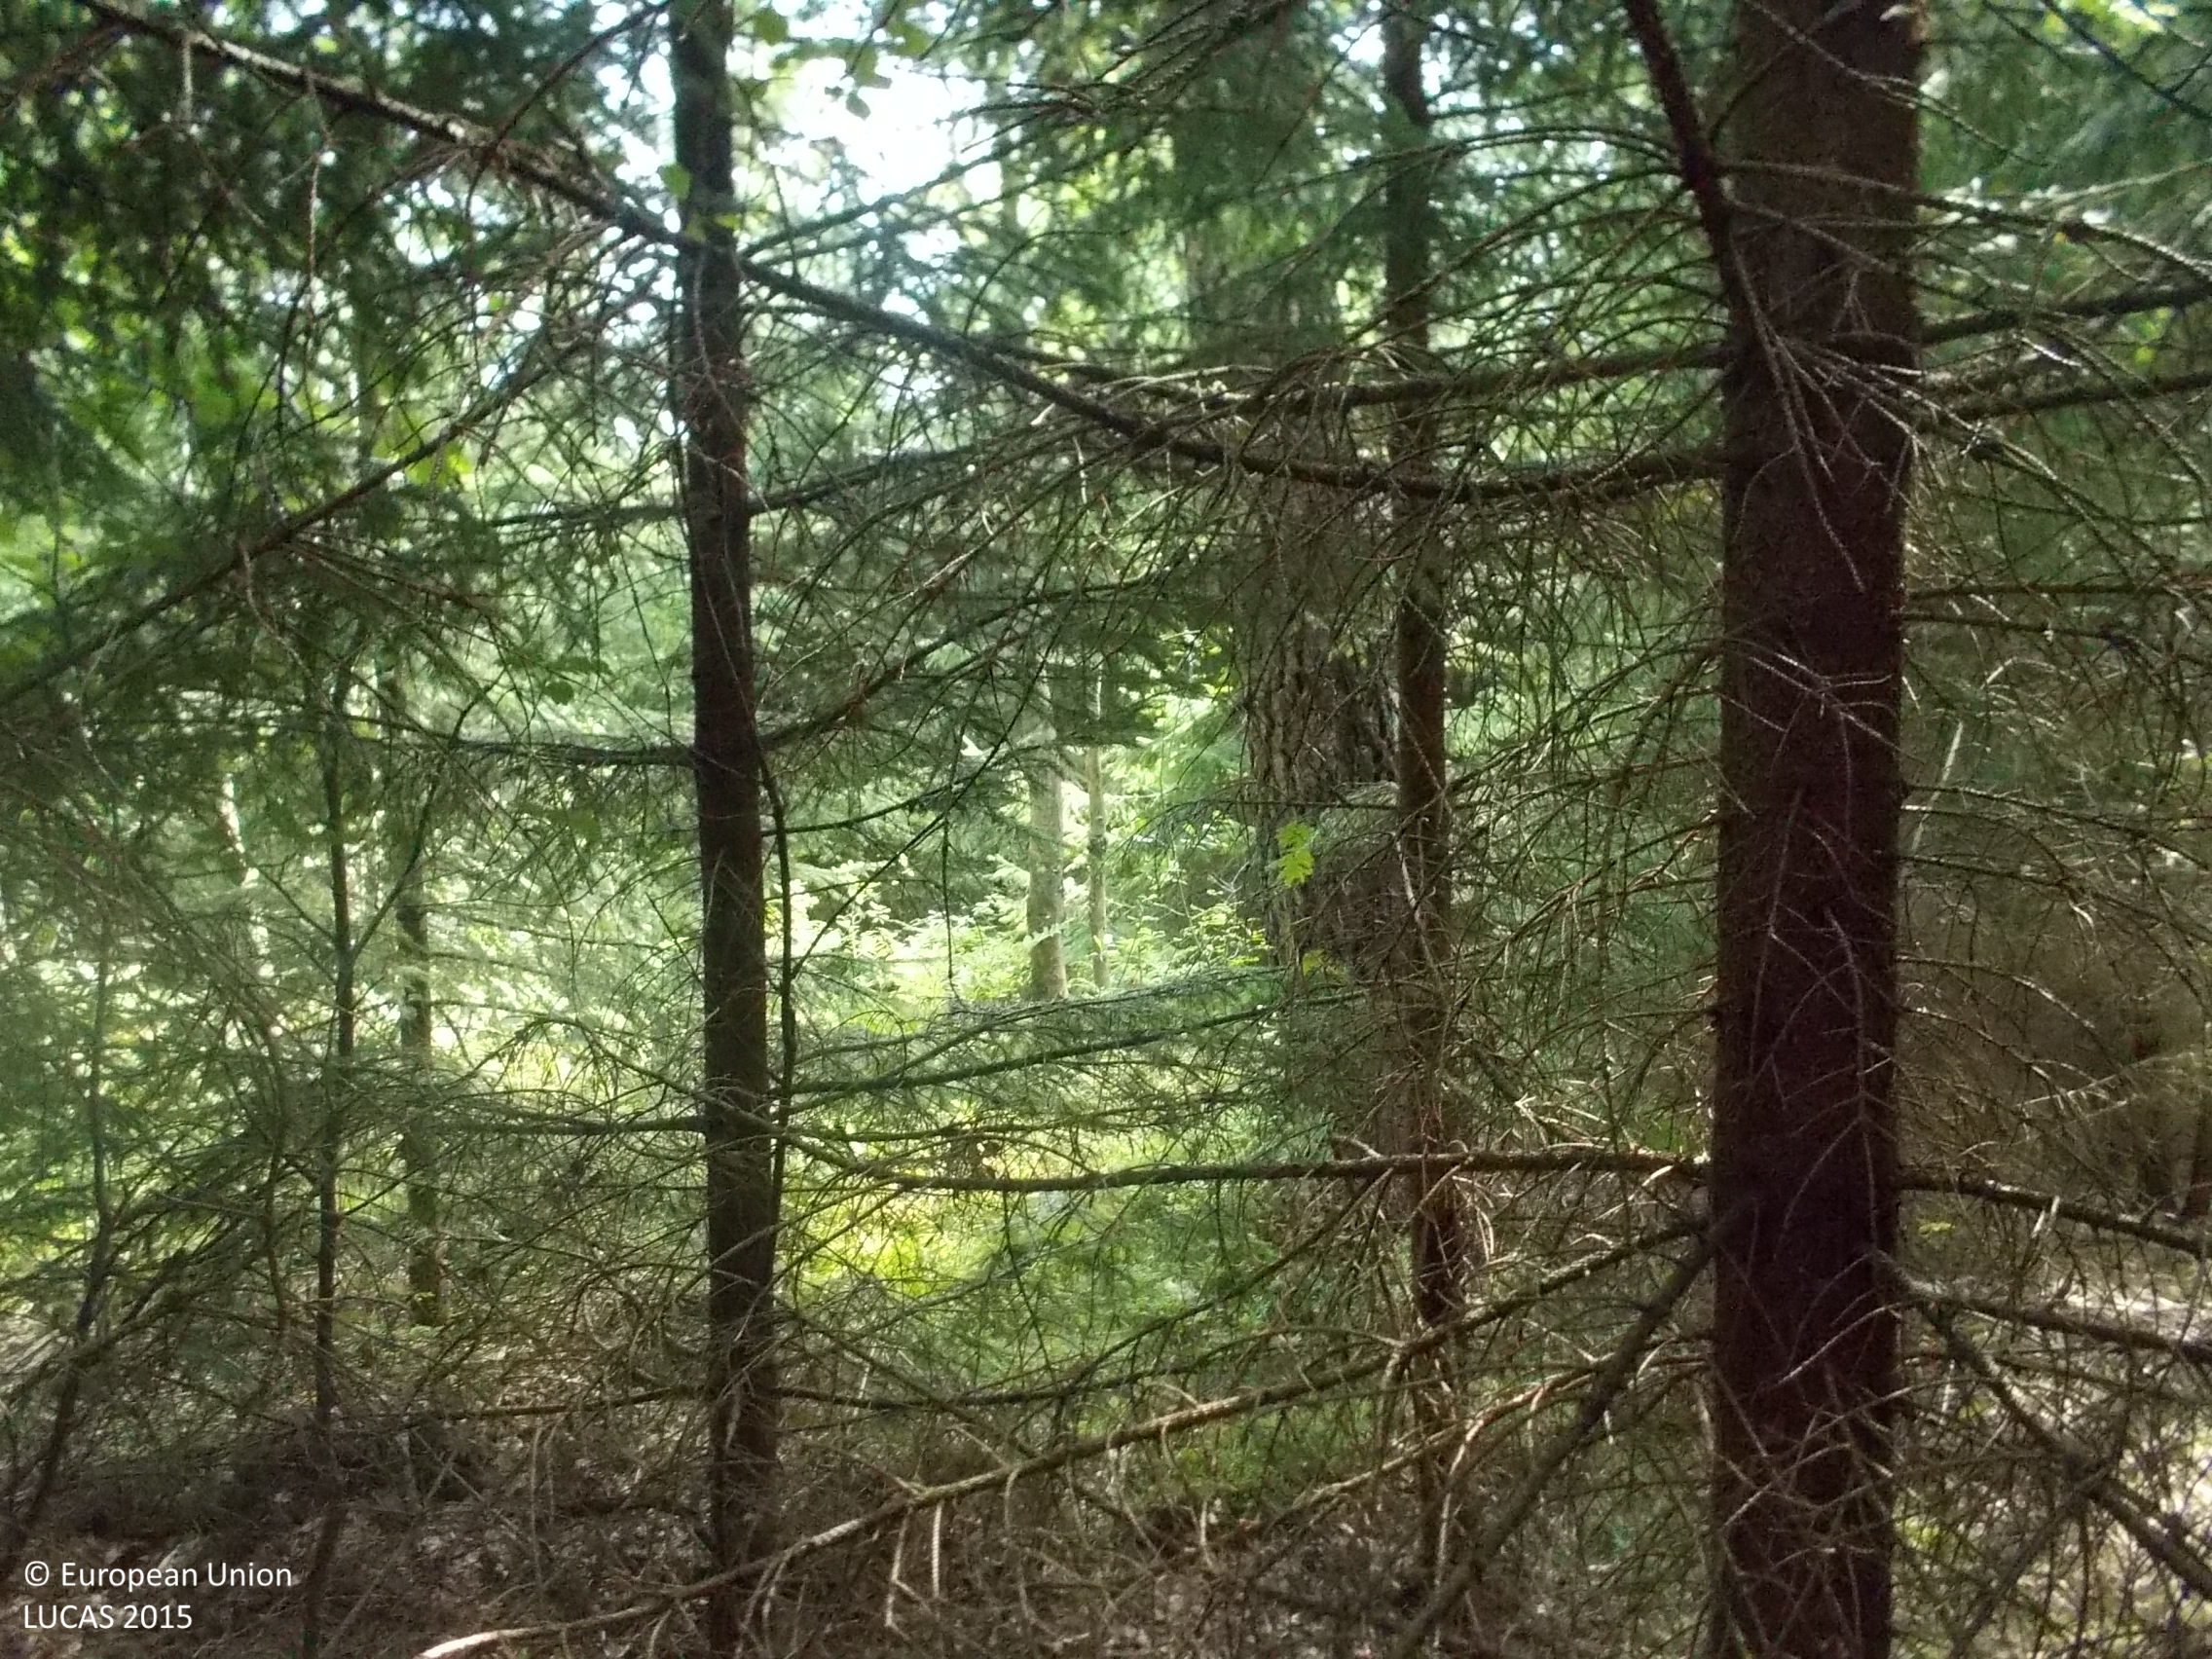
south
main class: Woodland
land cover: Spruce dominated coniferous woodland
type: boreal forest
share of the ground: > 75 %
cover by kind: coniferous forest trees 95 %, lichens and mosses 5 %
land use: Forestry
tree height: > 5 m
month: August
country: SE
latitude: 57.4823
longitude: 13.0814
